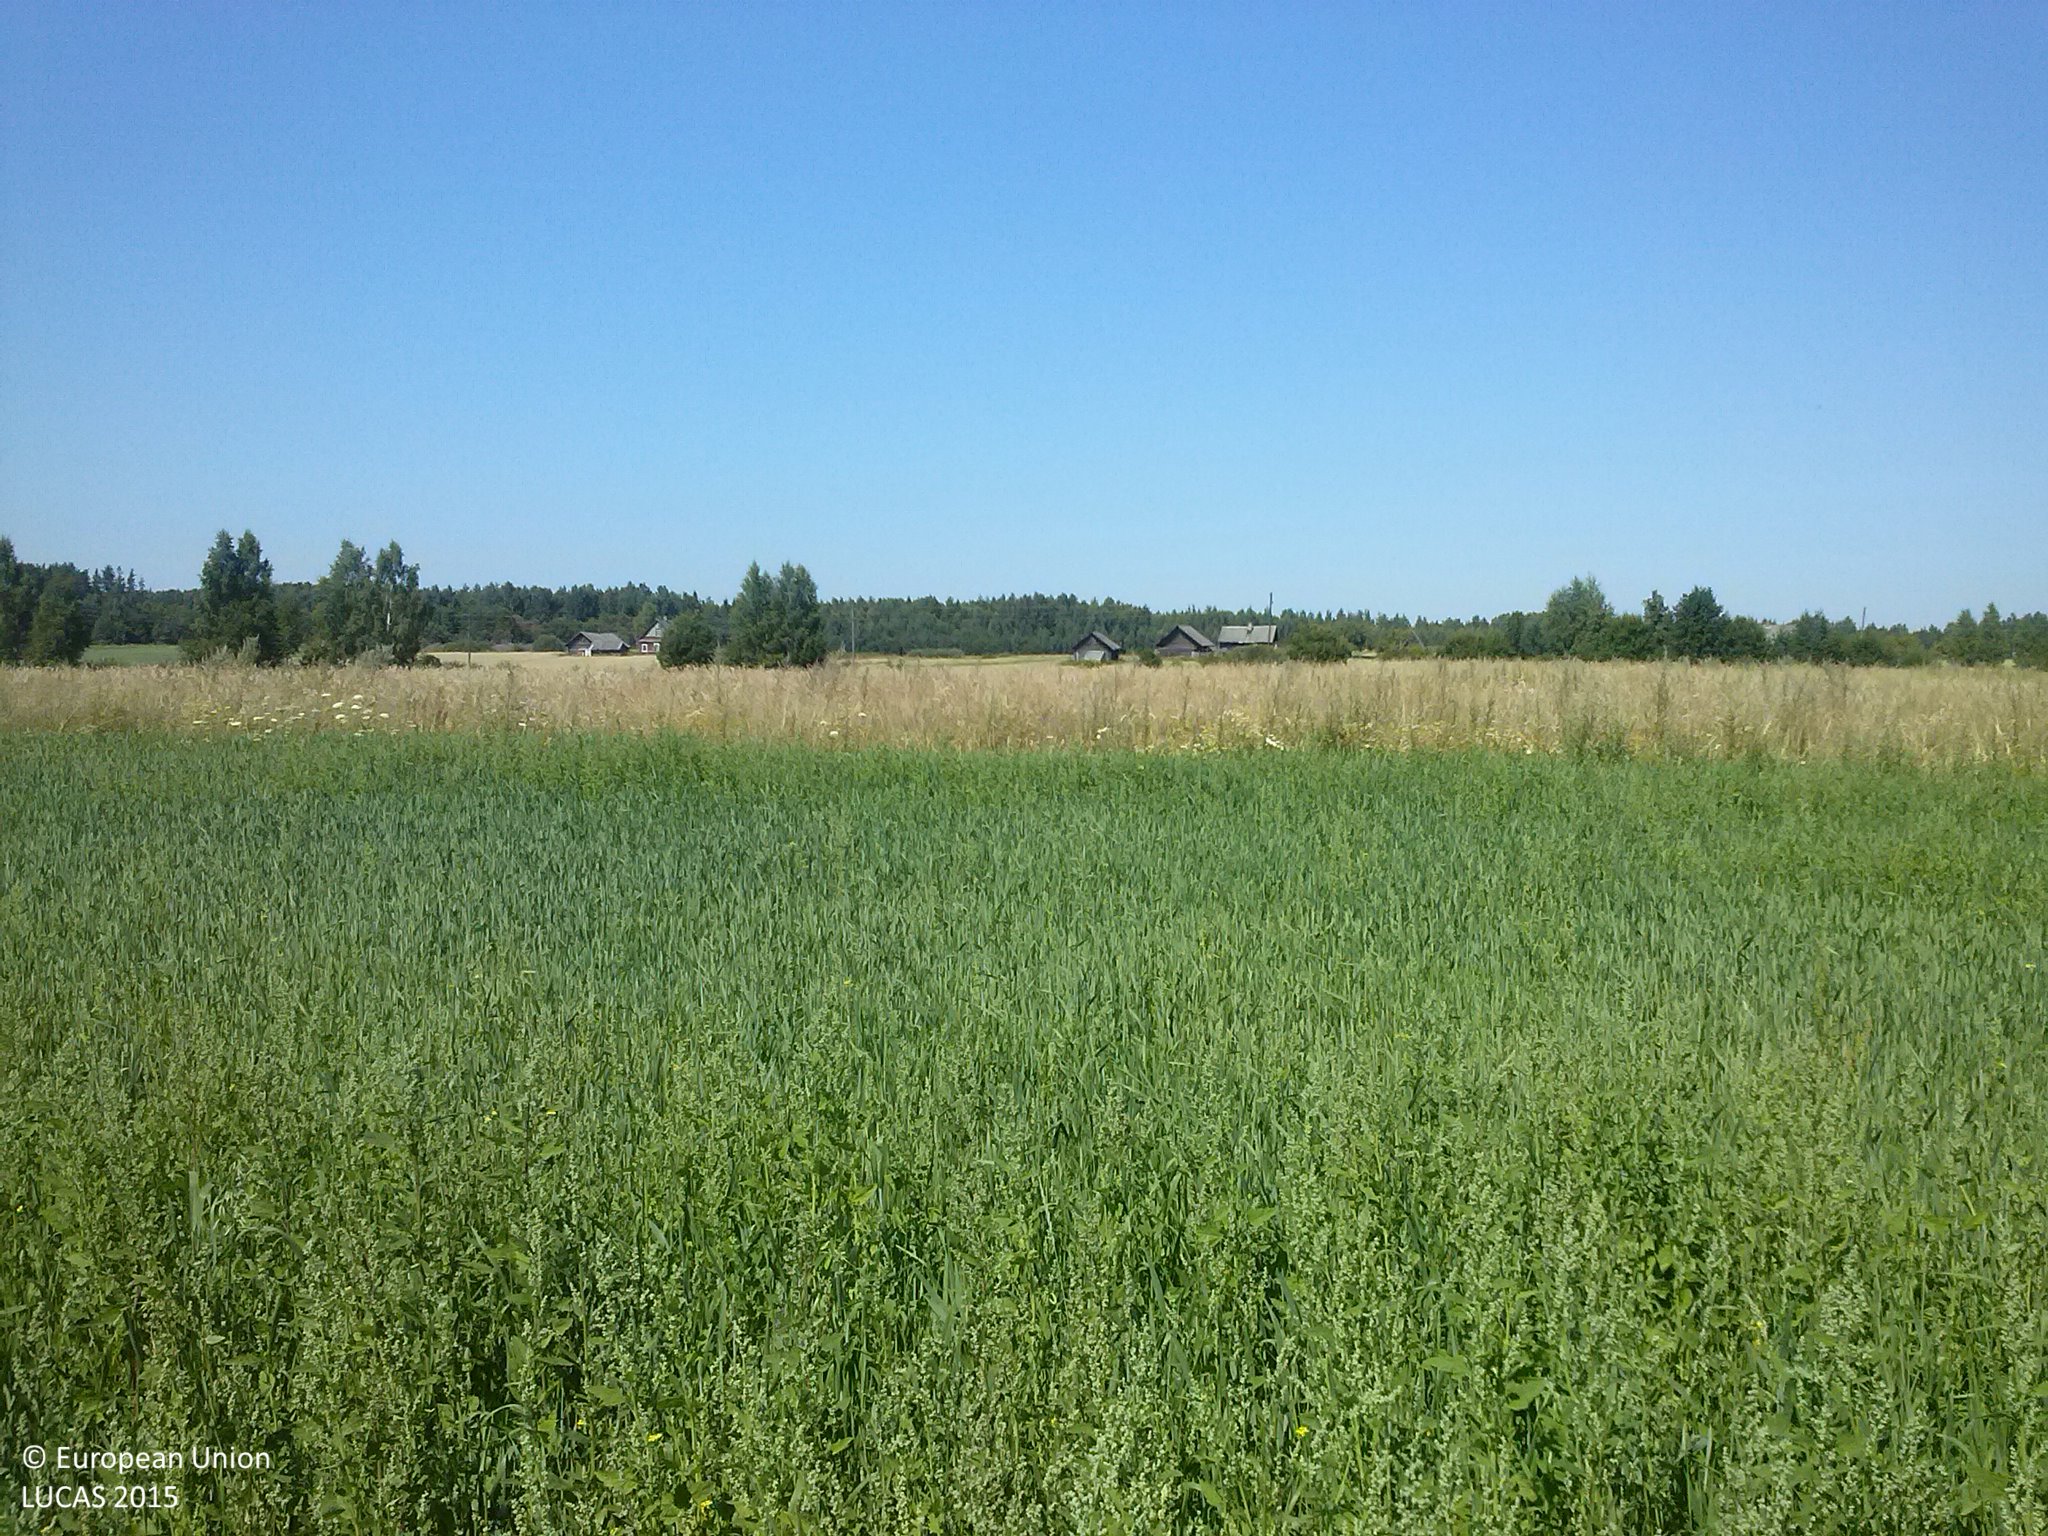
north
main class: Grassland
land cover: Grassland without tree/shrub cover
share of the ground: > 75 %
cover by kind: herbaceous plants 100 %
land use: Agriculture (excluding fallow land and kitchen gardens)
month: August
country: LV
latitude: 56.7344
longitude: 27.8270
